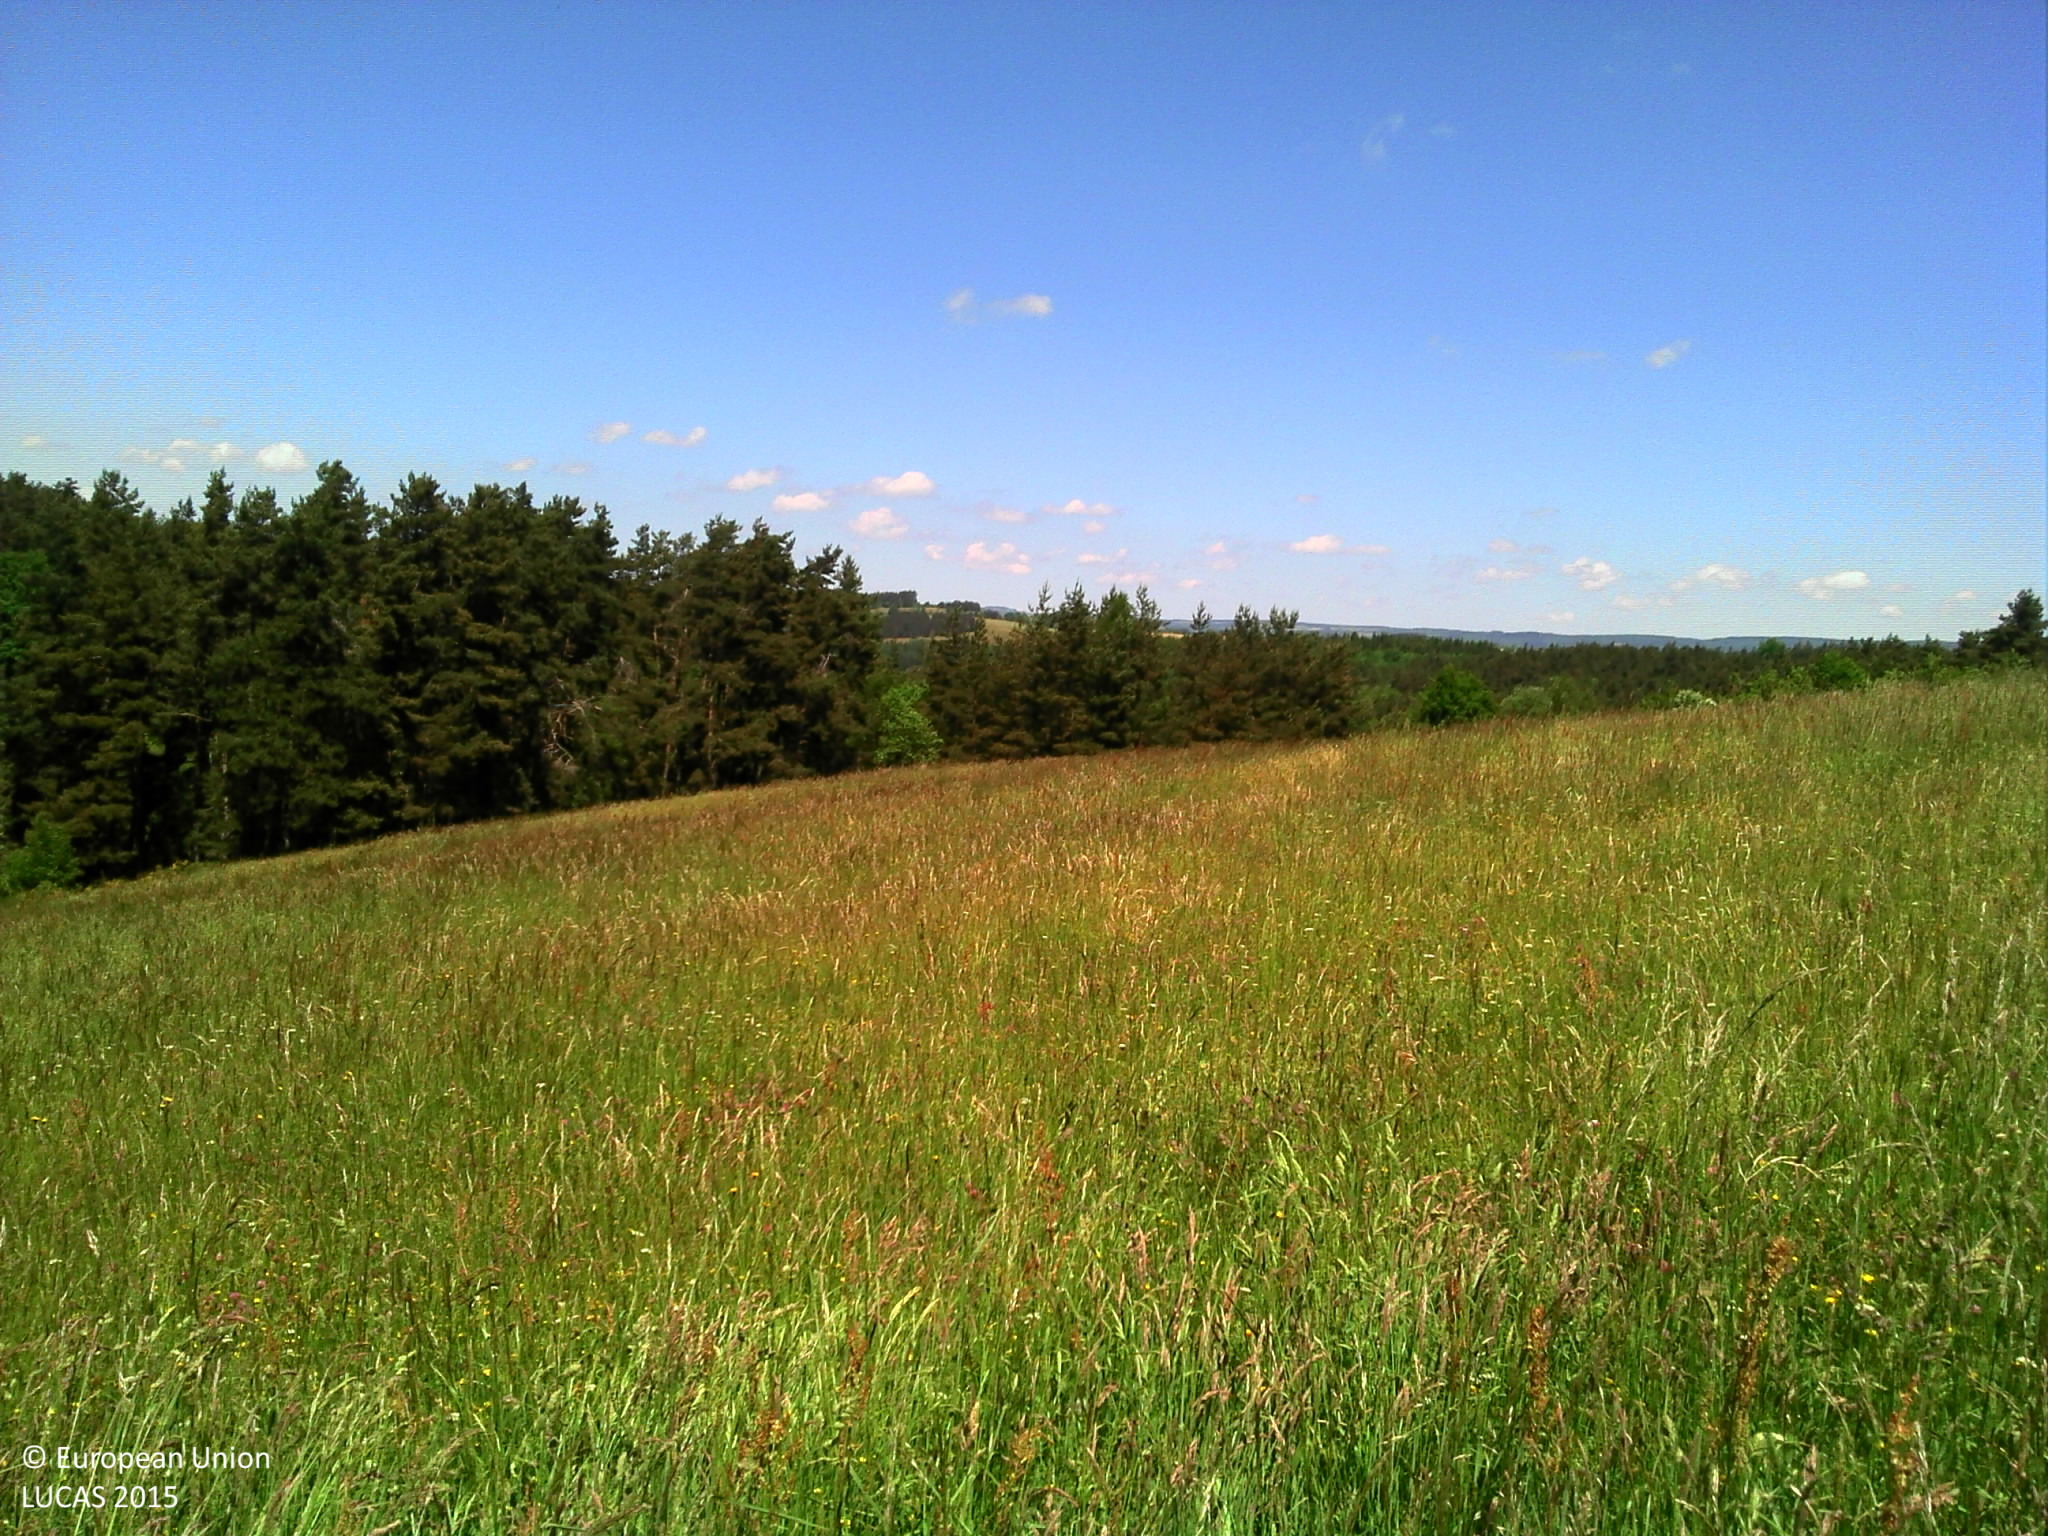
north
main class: Grassland
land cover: Grassland without tree/shrub cover
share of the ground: > 75 %
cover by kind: herbaceous plants 100 %
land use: Agriculture (excluding fallow land and kitchen gardens)
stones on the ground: < 10 %
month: June
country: FR
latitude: 44.9560
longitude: 3.1449
